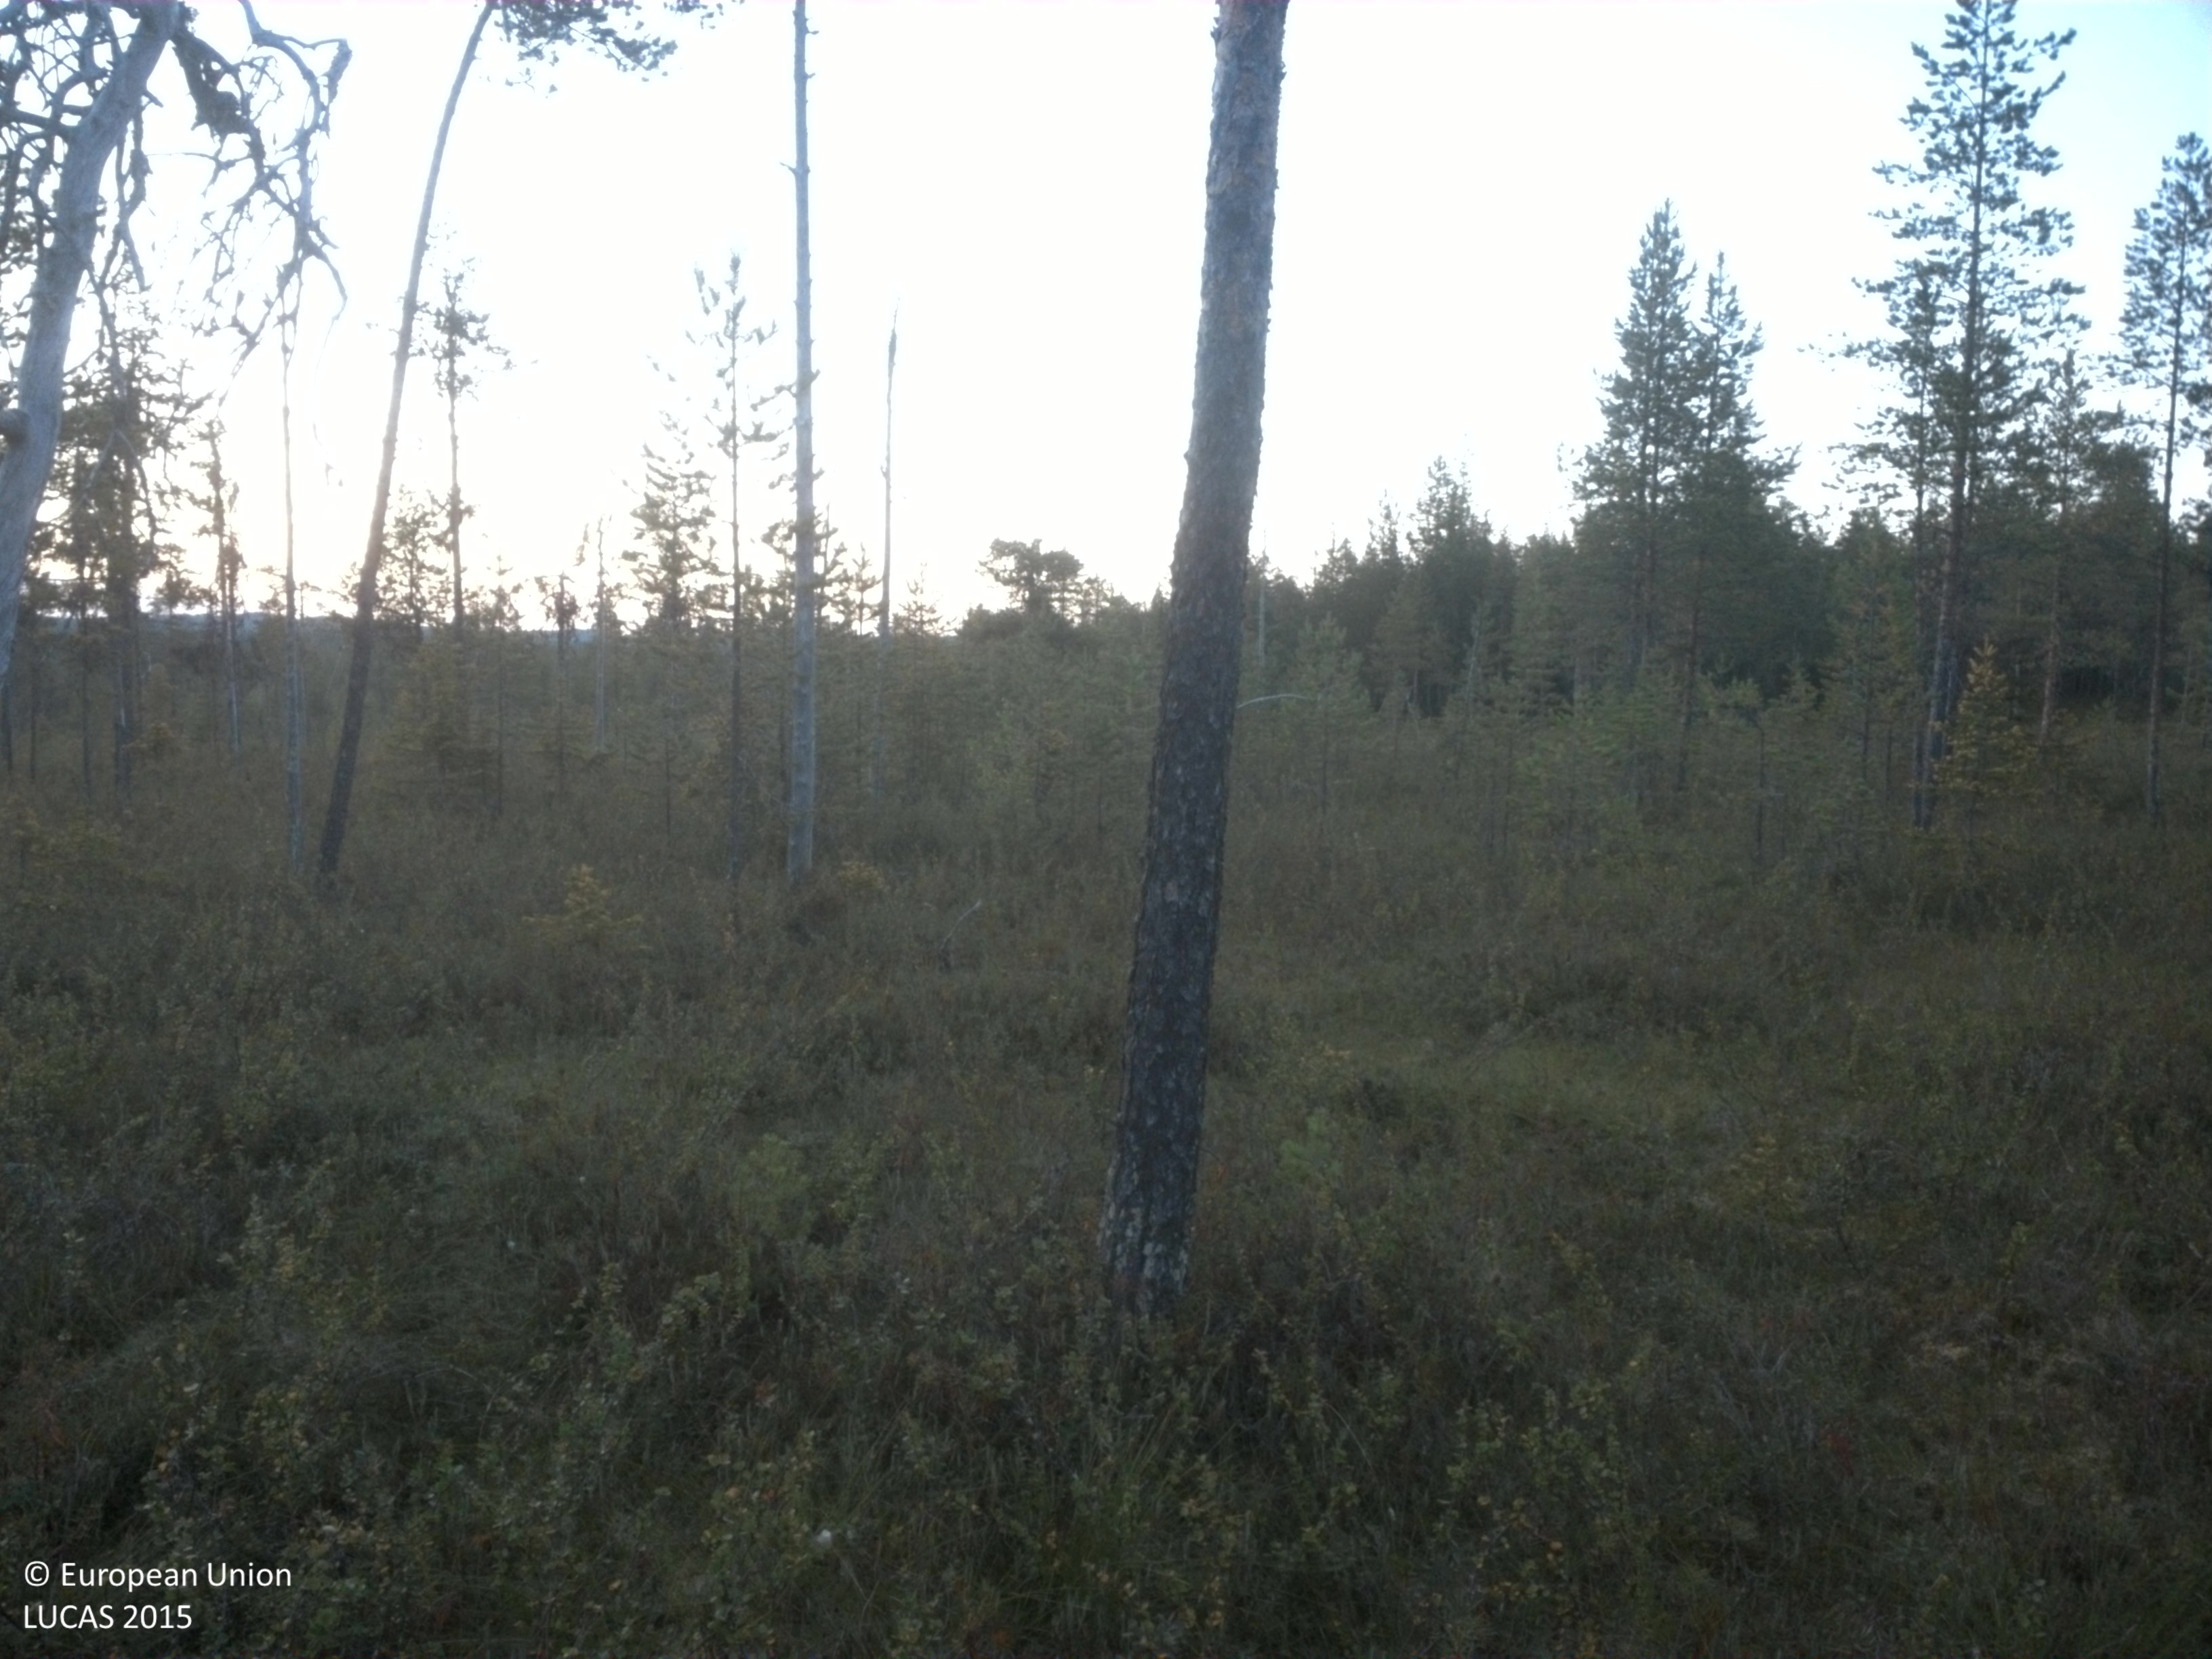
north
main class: Woodland
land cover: Pine dominated coniferous woodland
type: boreal forest
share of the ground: 10 - 25 %
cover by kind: shrubs 30 %, herbaceous plants 30 %, coniferous forest trees 20 %, lichens and mosses 20 %
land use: Forestry
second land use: Other primary production
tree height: > 5 m
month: August
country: SE
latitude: 64.6258
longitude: 18.8150
